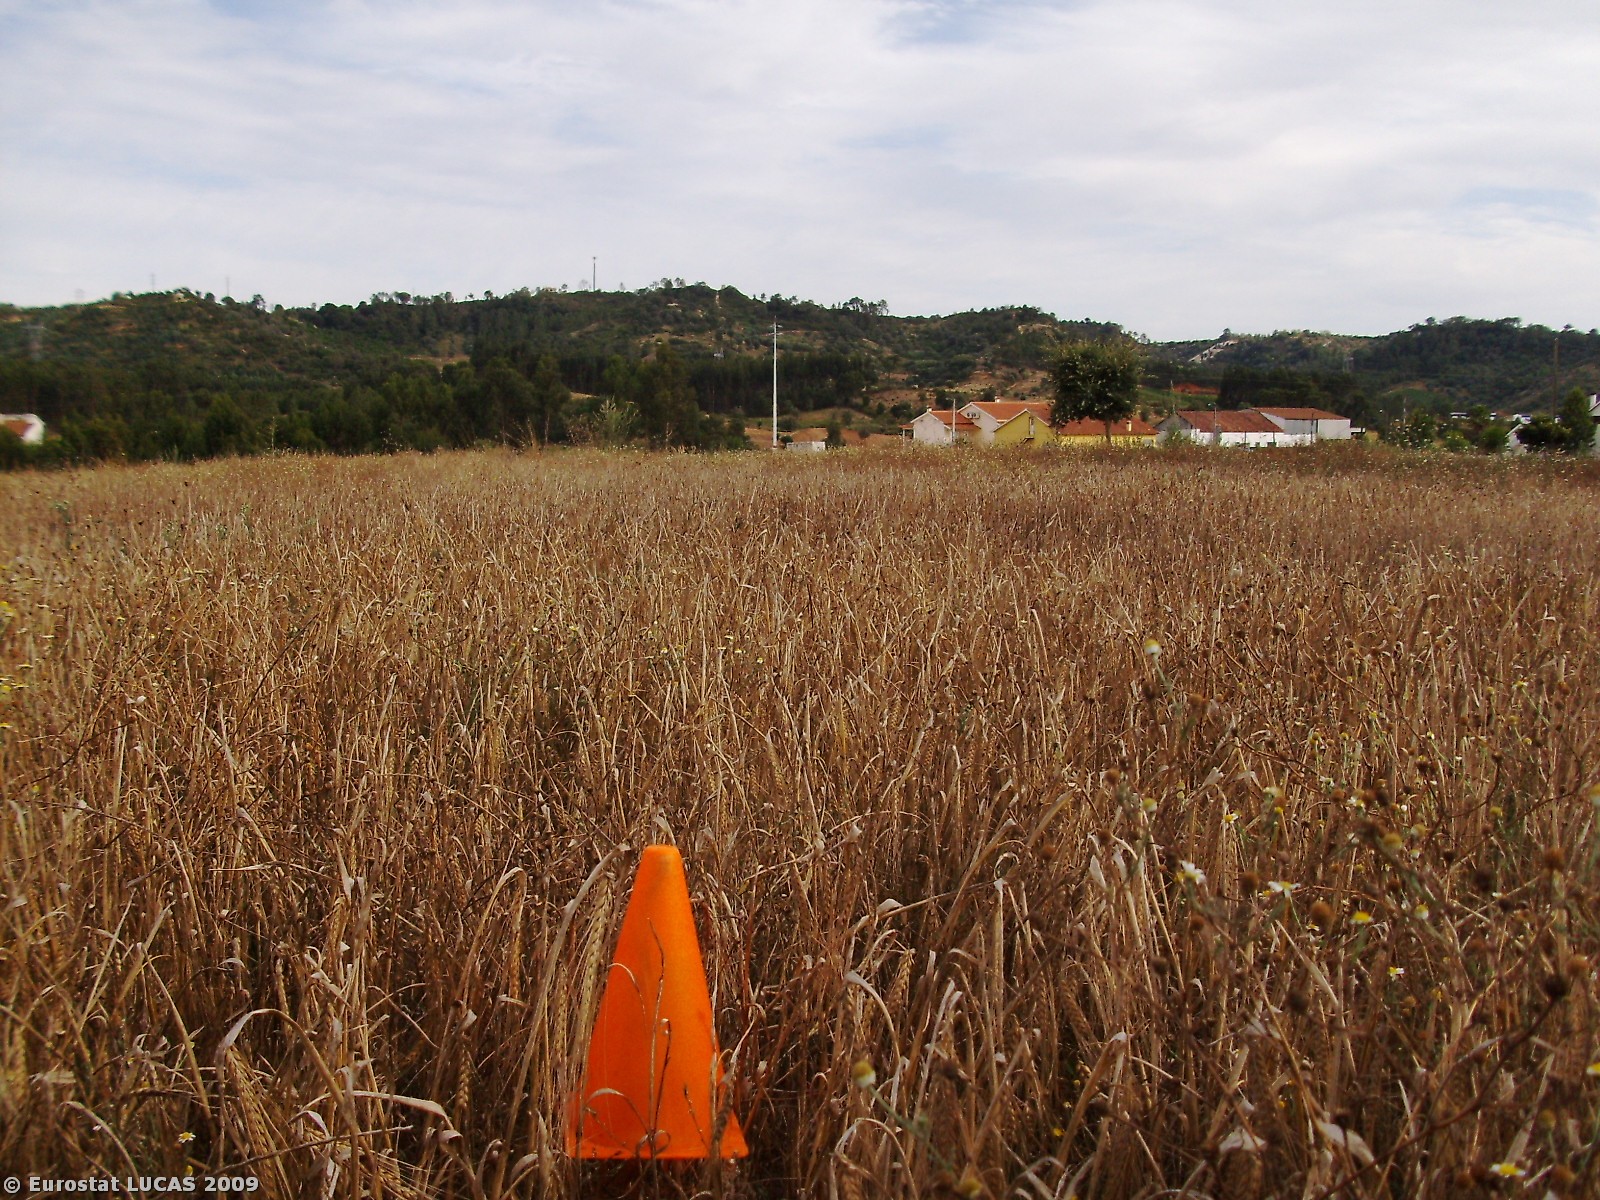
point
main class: Cropland
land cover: Barley
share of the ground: > 75 %
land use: Agriculture (excluding fallow land and kitchen gardens)
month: July
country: PT
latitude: 39.3621
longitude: -8.7749
